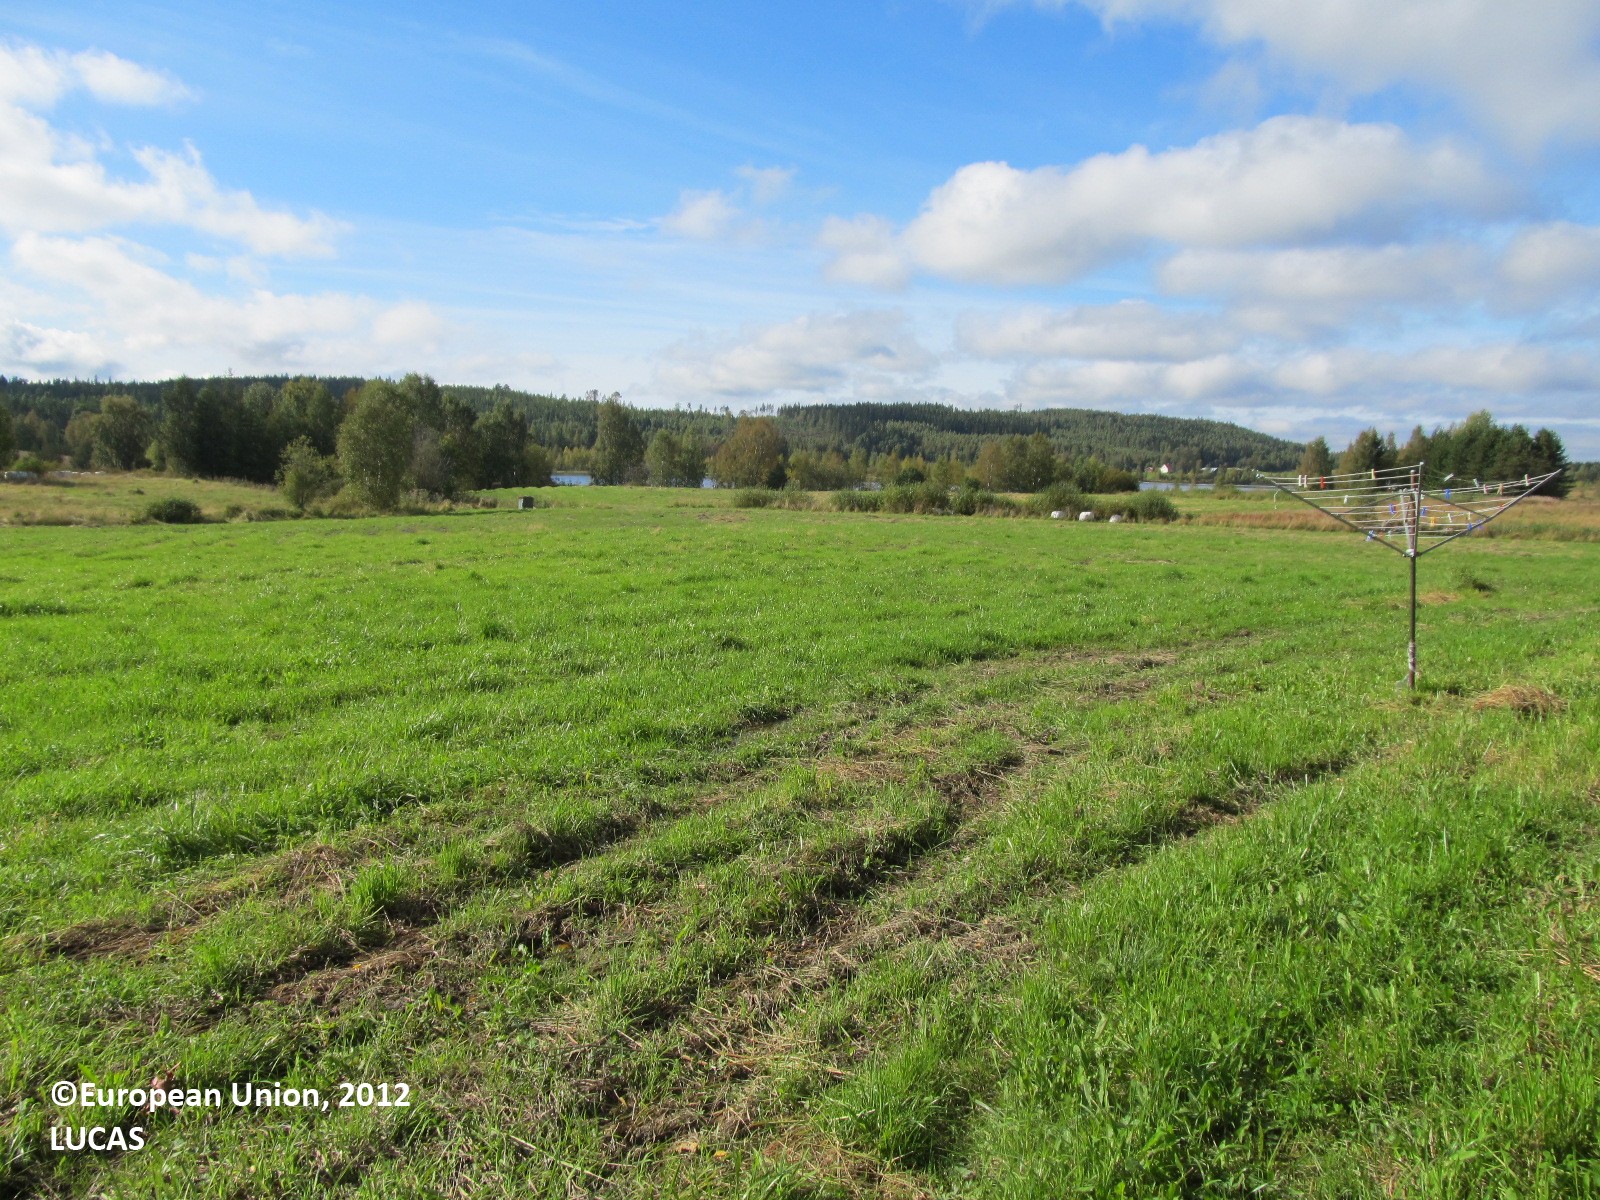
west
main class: Cropland
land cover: Temporary grasslands
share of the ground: 50 - 75 %
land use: Agriculture (excluding fallow land and kitchen gardens)
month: September
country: FI
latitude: 62.9723
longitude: 28.2347
